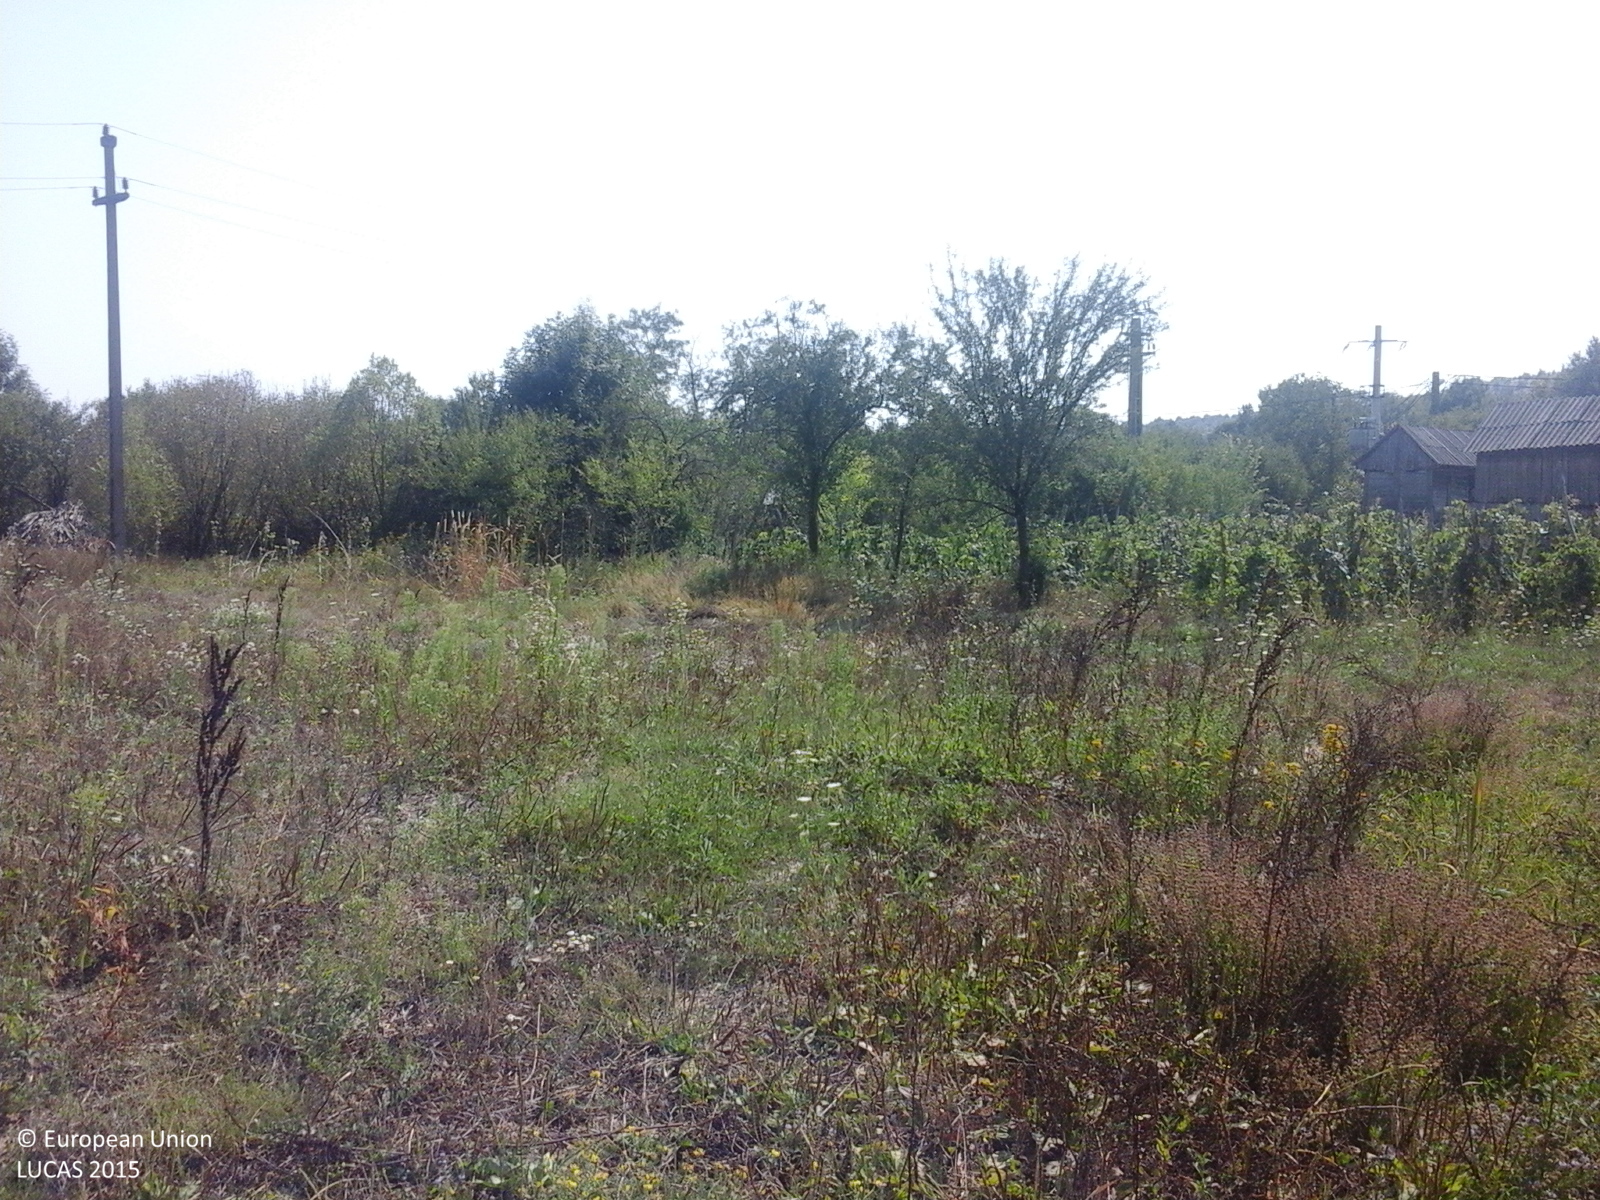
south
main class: Cropland
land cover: Vineyards
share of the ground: 50 - 75 %
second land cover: Other bare soil
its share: > 75 %
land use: Agriculture (excluding fallow land and kitchen gardens)
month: August
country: RO
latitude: 44.6568
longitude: 23.8697
